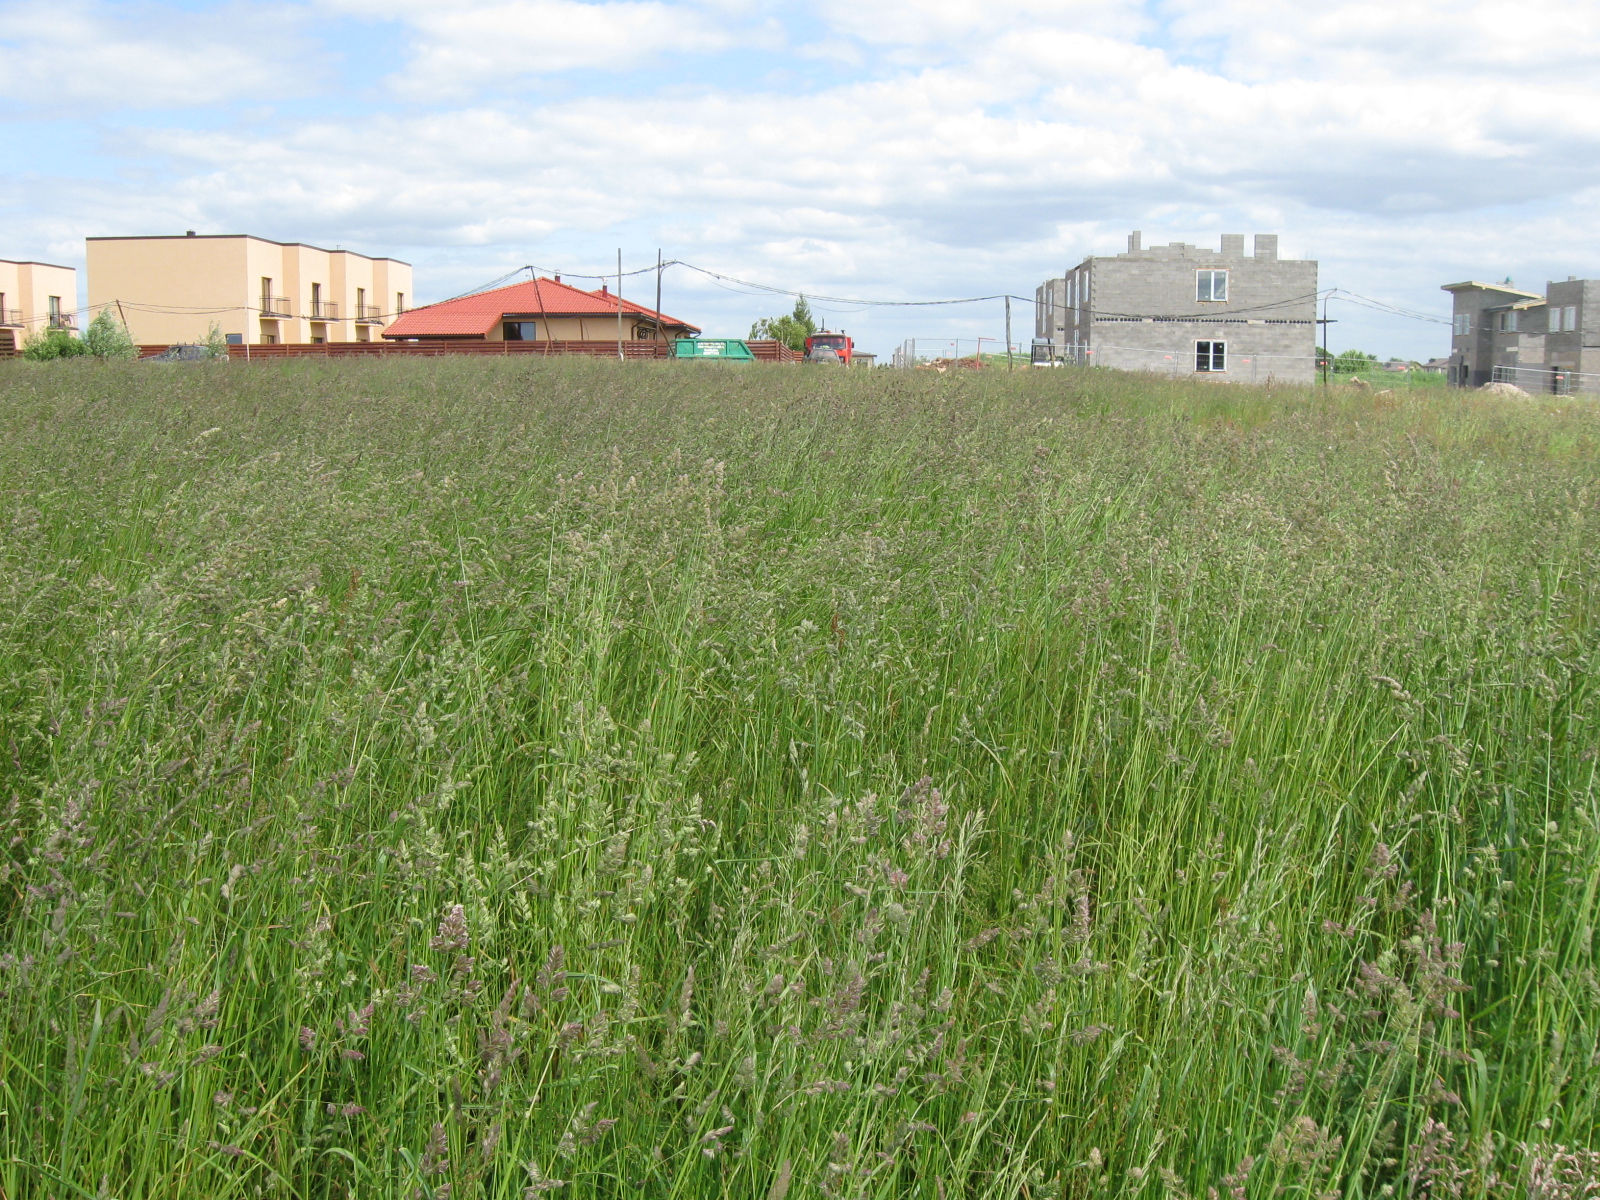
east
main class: Grassland
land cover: Grassland without tree/shrub cover
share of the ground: > 75 %
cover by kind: herbaceous plants 100 %
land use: Agriculture (excluding fallow land and kitchen gardens)
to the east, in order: Grassland without tree/shrub cover; Artificial constructions in urban areas; Spontaneously vegetated surfaces; Grassland with sparse tree/shrub cover; Spontaneously vegetated surfaces; Other bare soil; Grassland with sparse tree/shrub cover
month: June
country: LT
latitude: 54.9606
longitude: 23.8150
